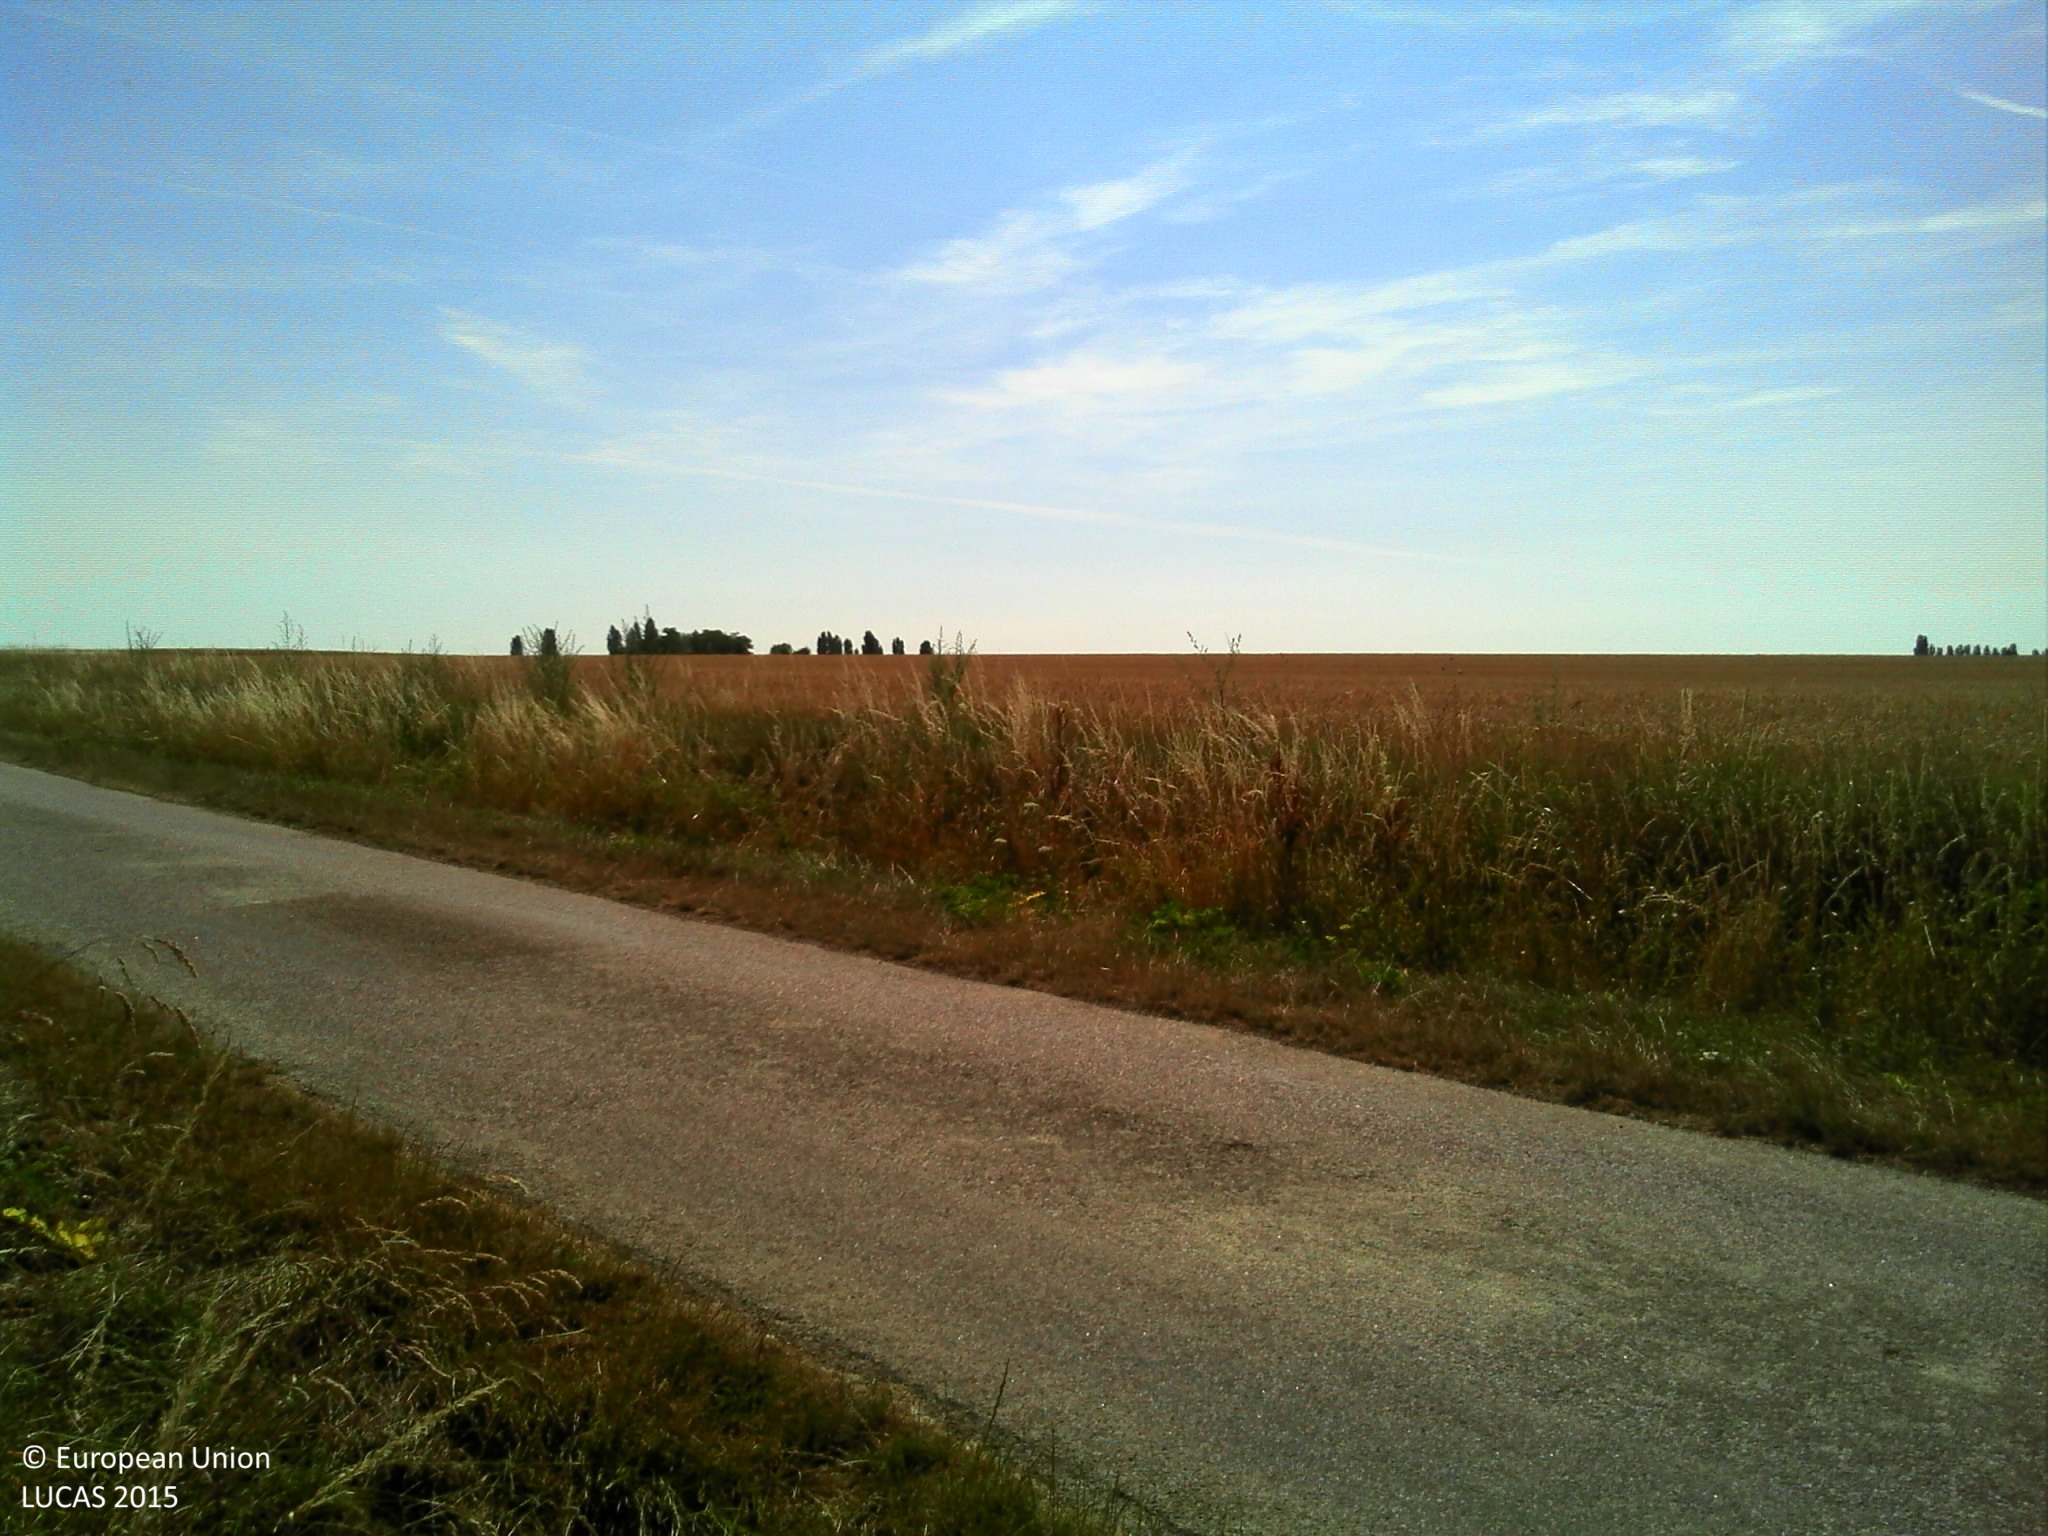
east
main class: Cropland
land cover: Rape and turnip rape
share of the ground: > 75 %
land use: Agriculture (excluding fallow land and kitchen gardens)
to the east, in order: Rape and turnip rape
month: July
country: FR
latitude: 47.9512
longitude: 3.0707
